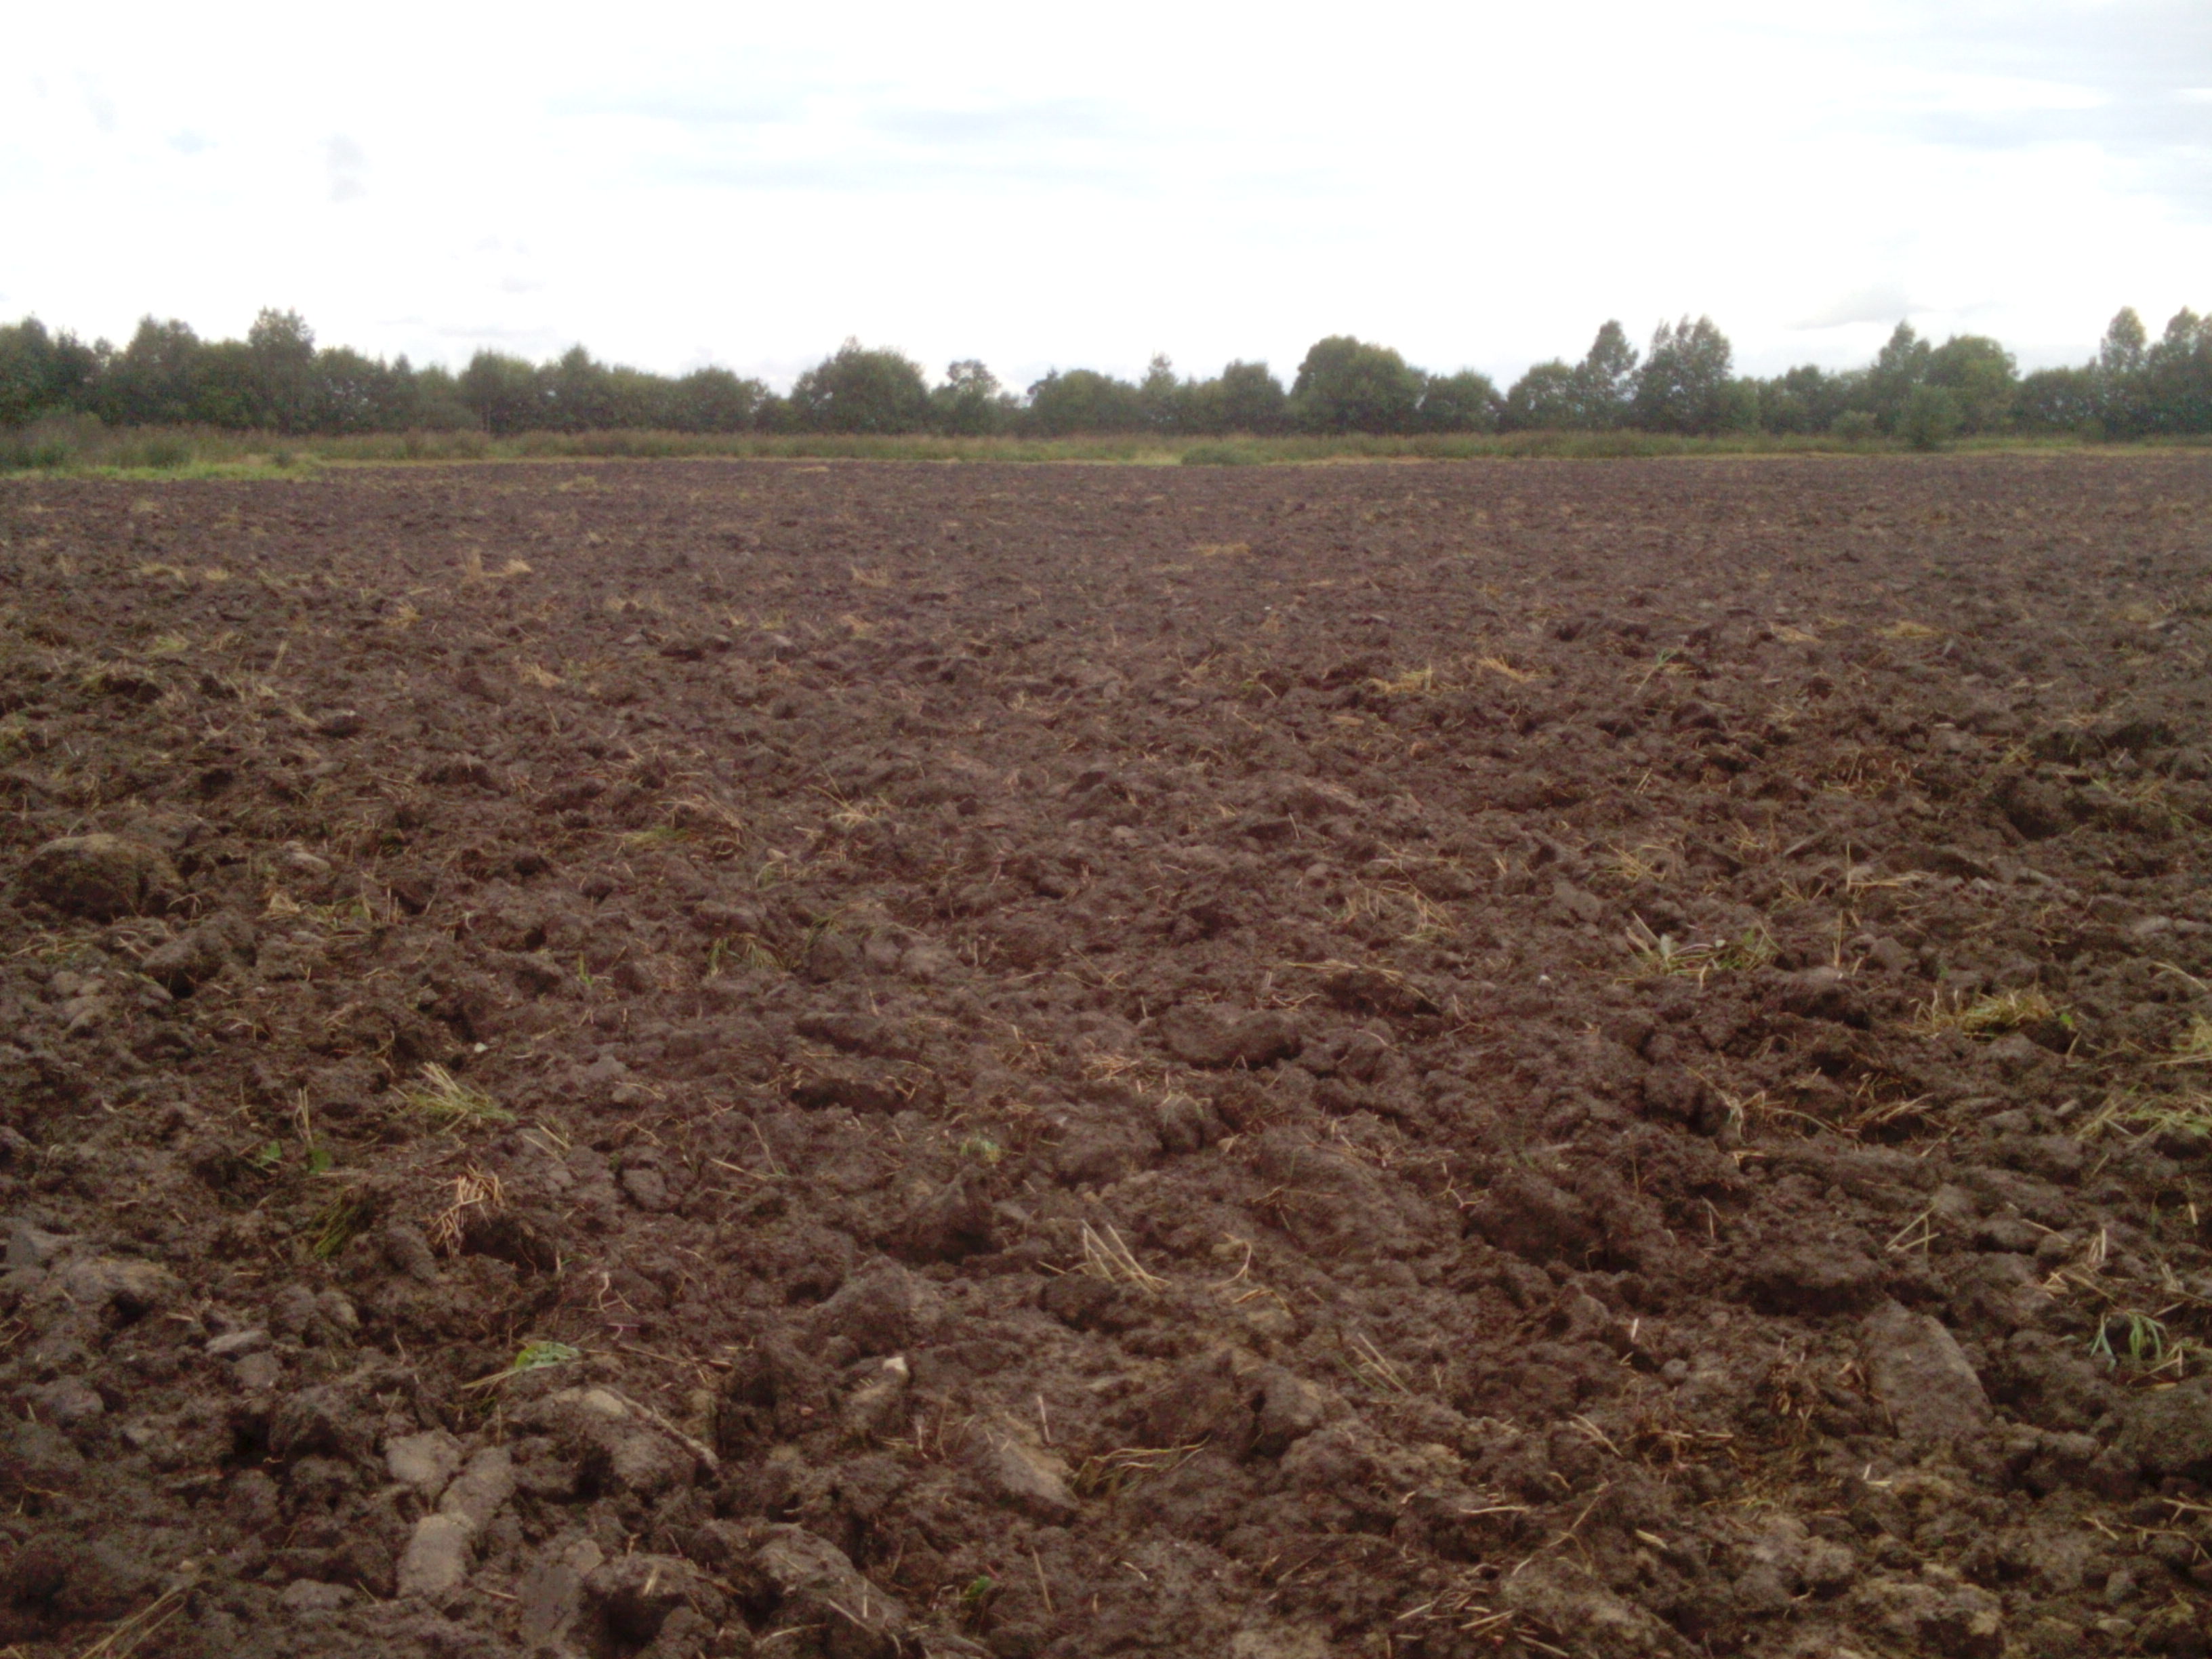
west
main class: Cropland
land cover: Barley
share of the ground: < 10 %
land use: Agriculture (excluding fallow land and kitchen gardens)
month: September
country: LT
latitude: 55.9016
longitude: 22.6820
